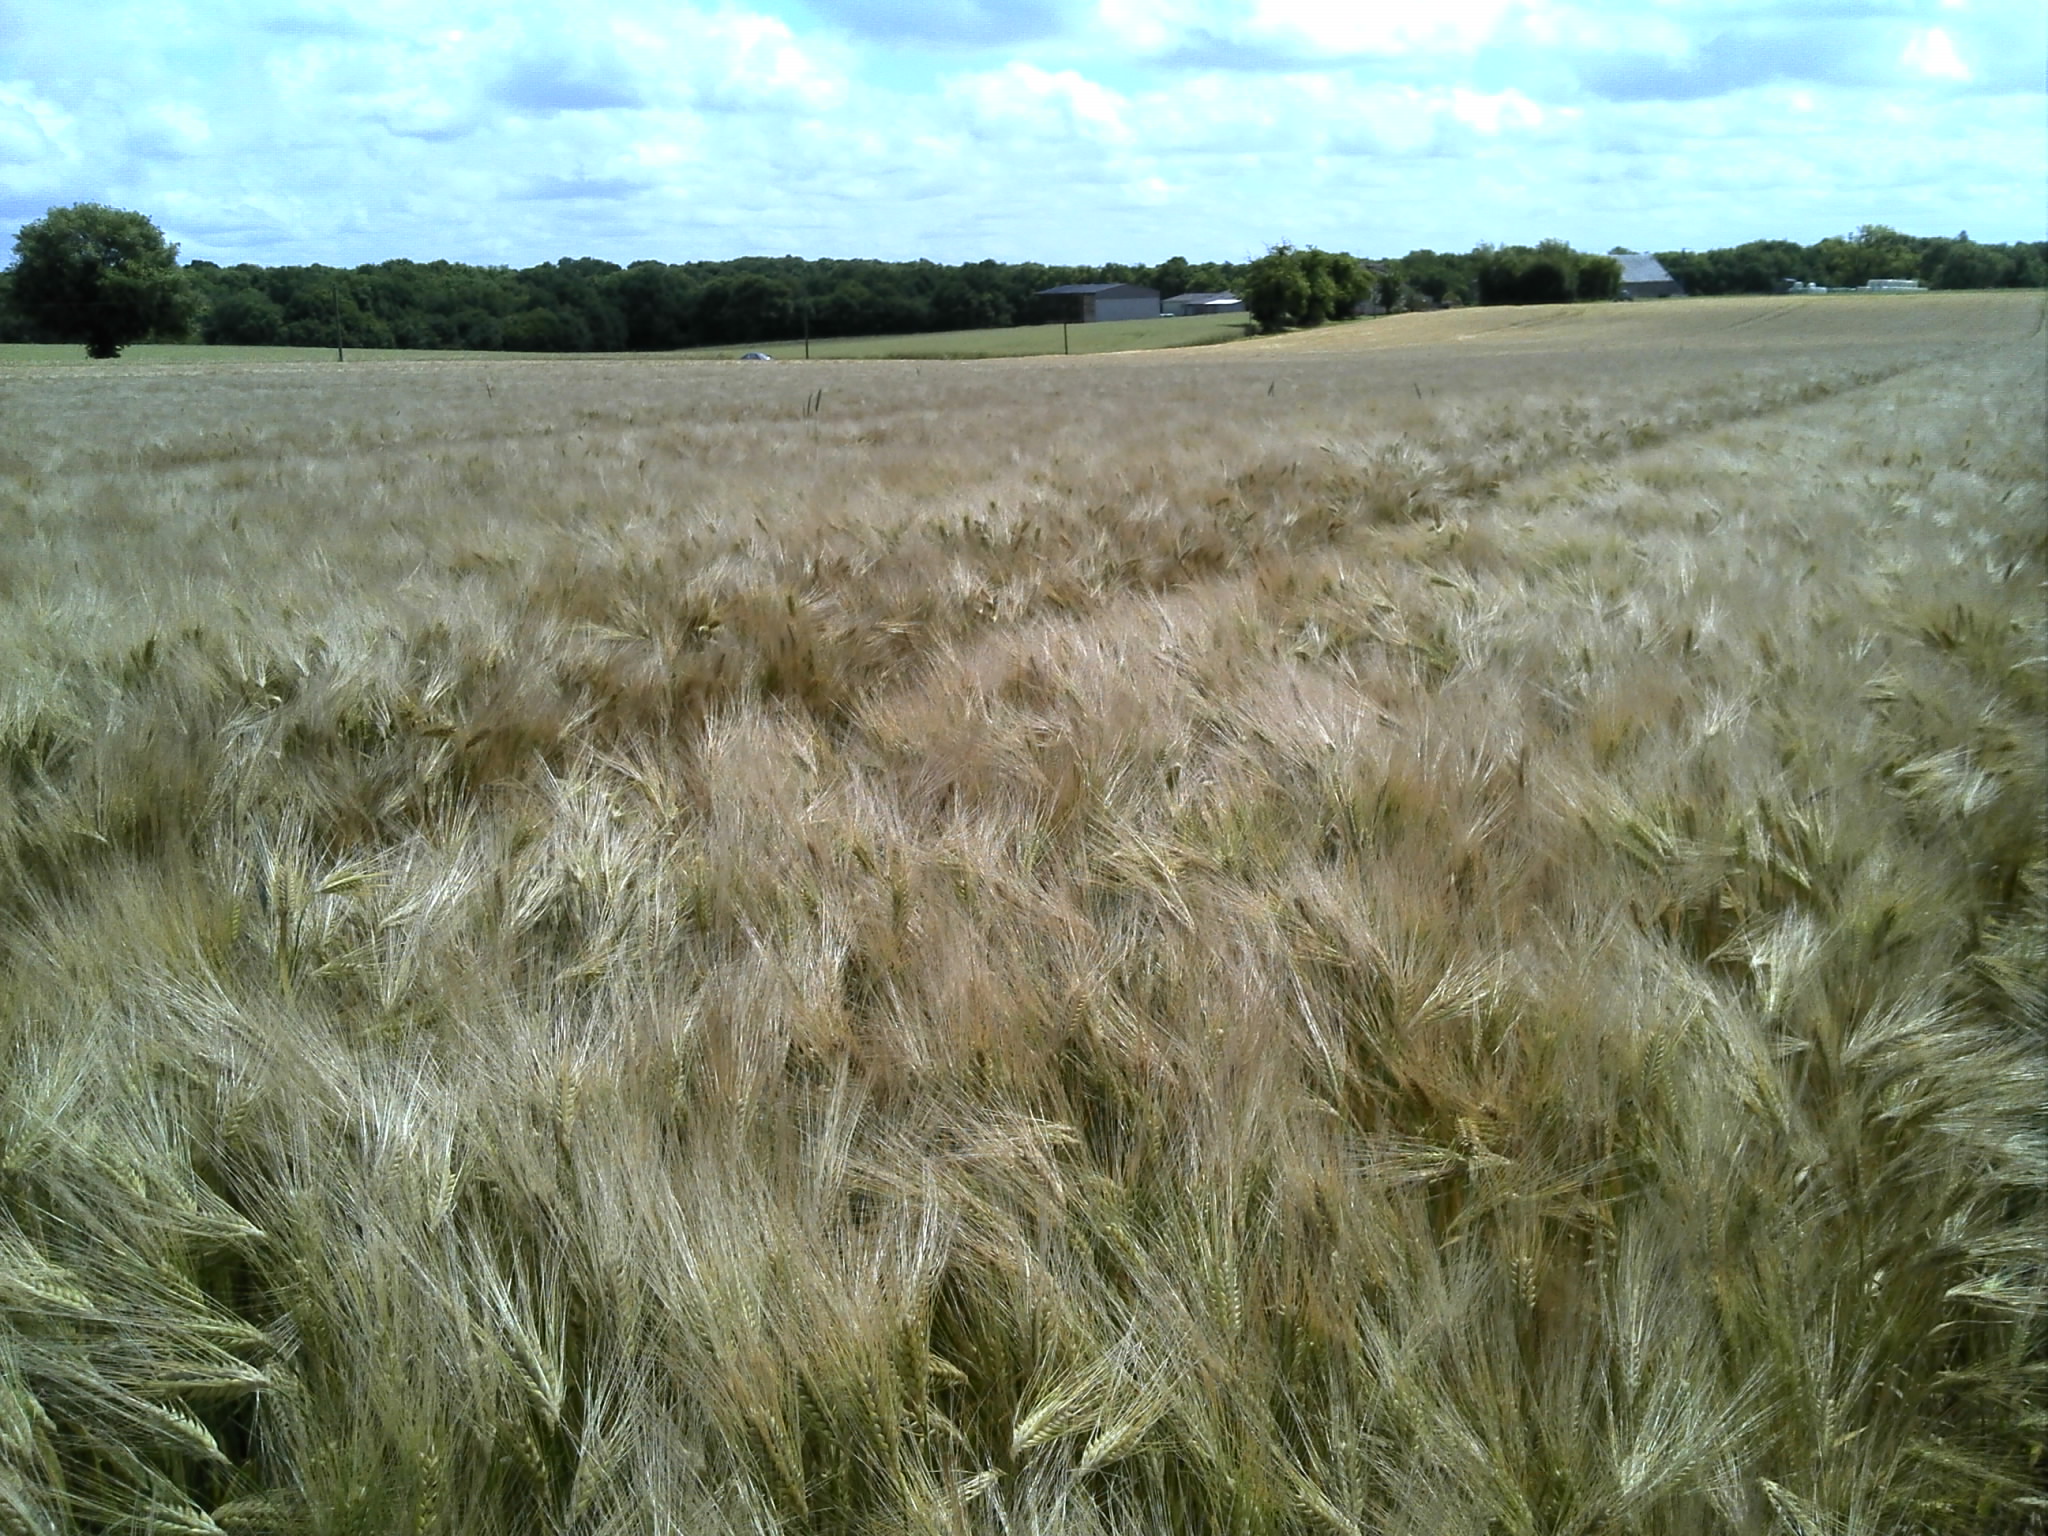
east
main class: Cropland
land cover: Barley
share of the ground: > 75 %
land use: Agriculture (excluding fallow land and kitchen gardens)
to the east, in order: Barley; Grass margins; Electric lines; Ditches and canals; Grass margins; Paved roads, cycling and walking lanes; Grass margins; Ditches and canals; Grass margins; Rape and turnip rape
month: June
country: FR
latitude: 46.6627
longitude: 1.4809
